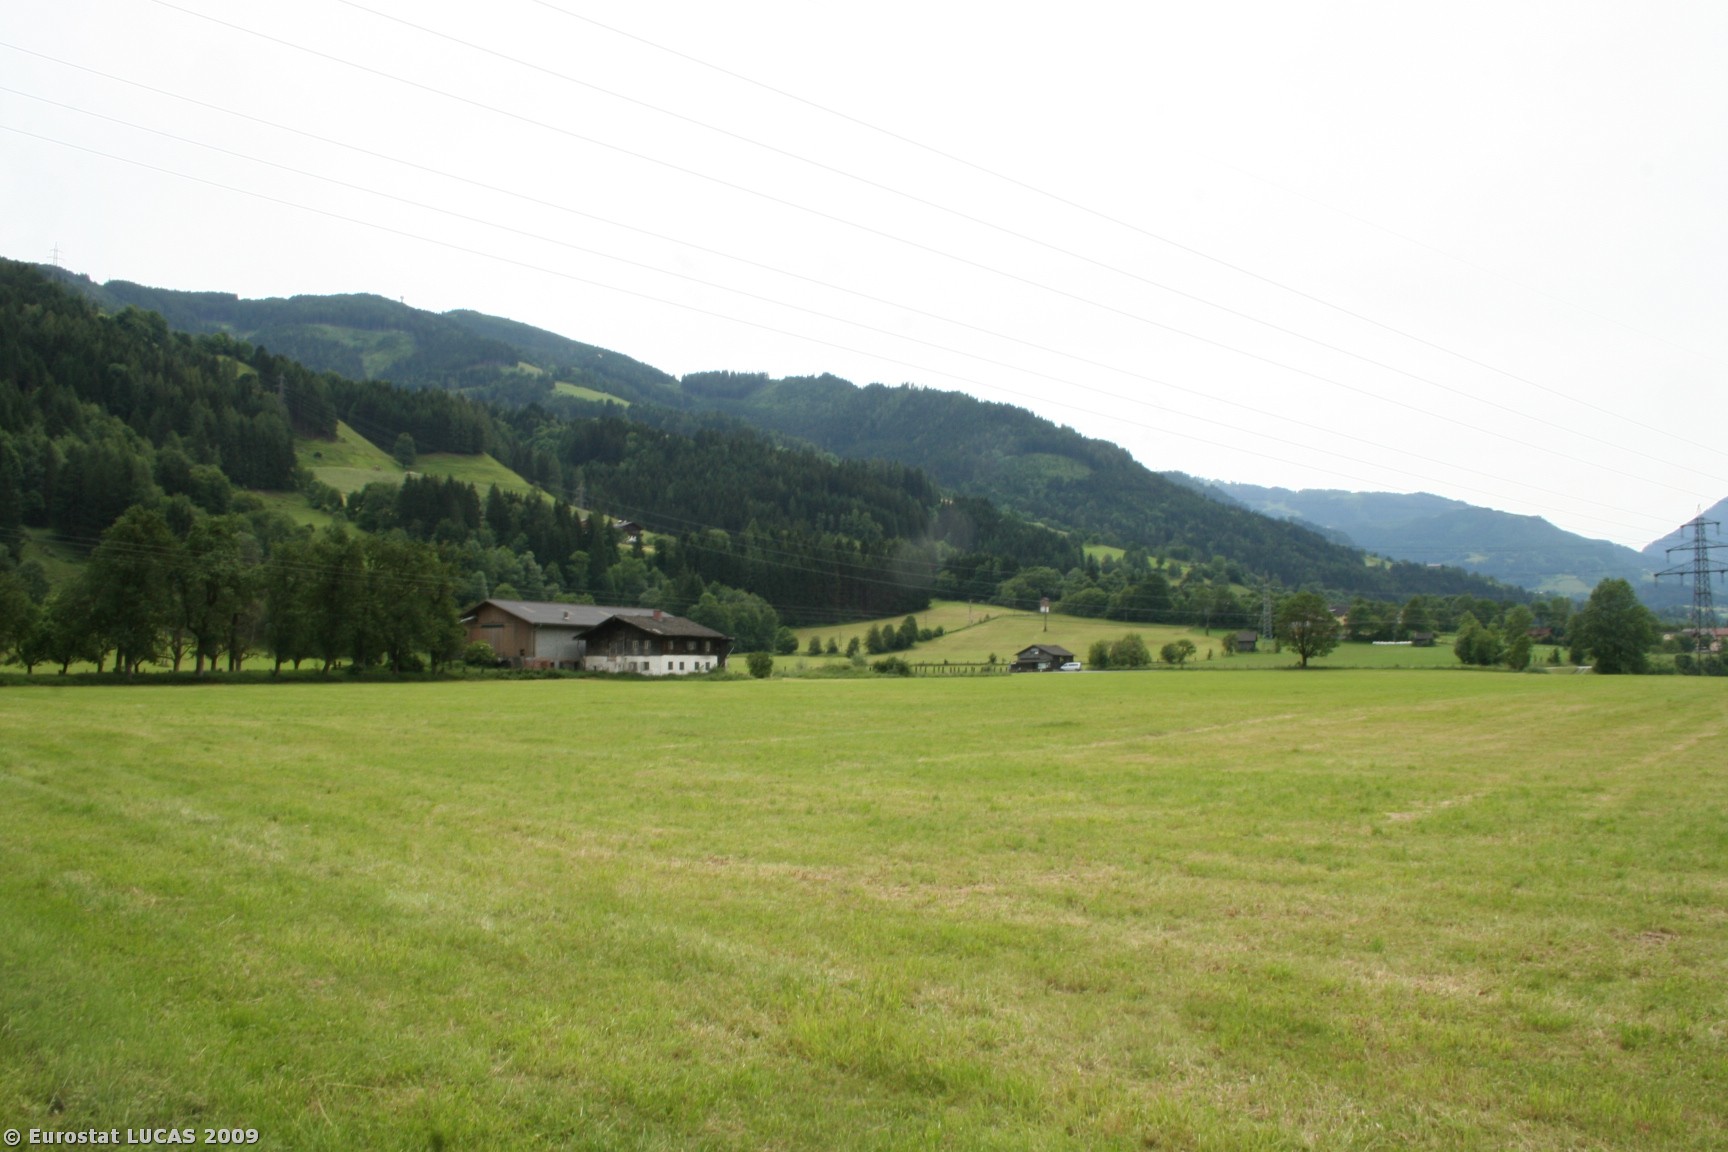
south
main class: Grassland
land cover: Grassland without tree/shrub cover
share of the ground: > 75 %
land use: Agriculture (excluding fallow land and kitchen gardens)
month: June
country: AT
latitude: 47.3841
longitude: 13.2170
